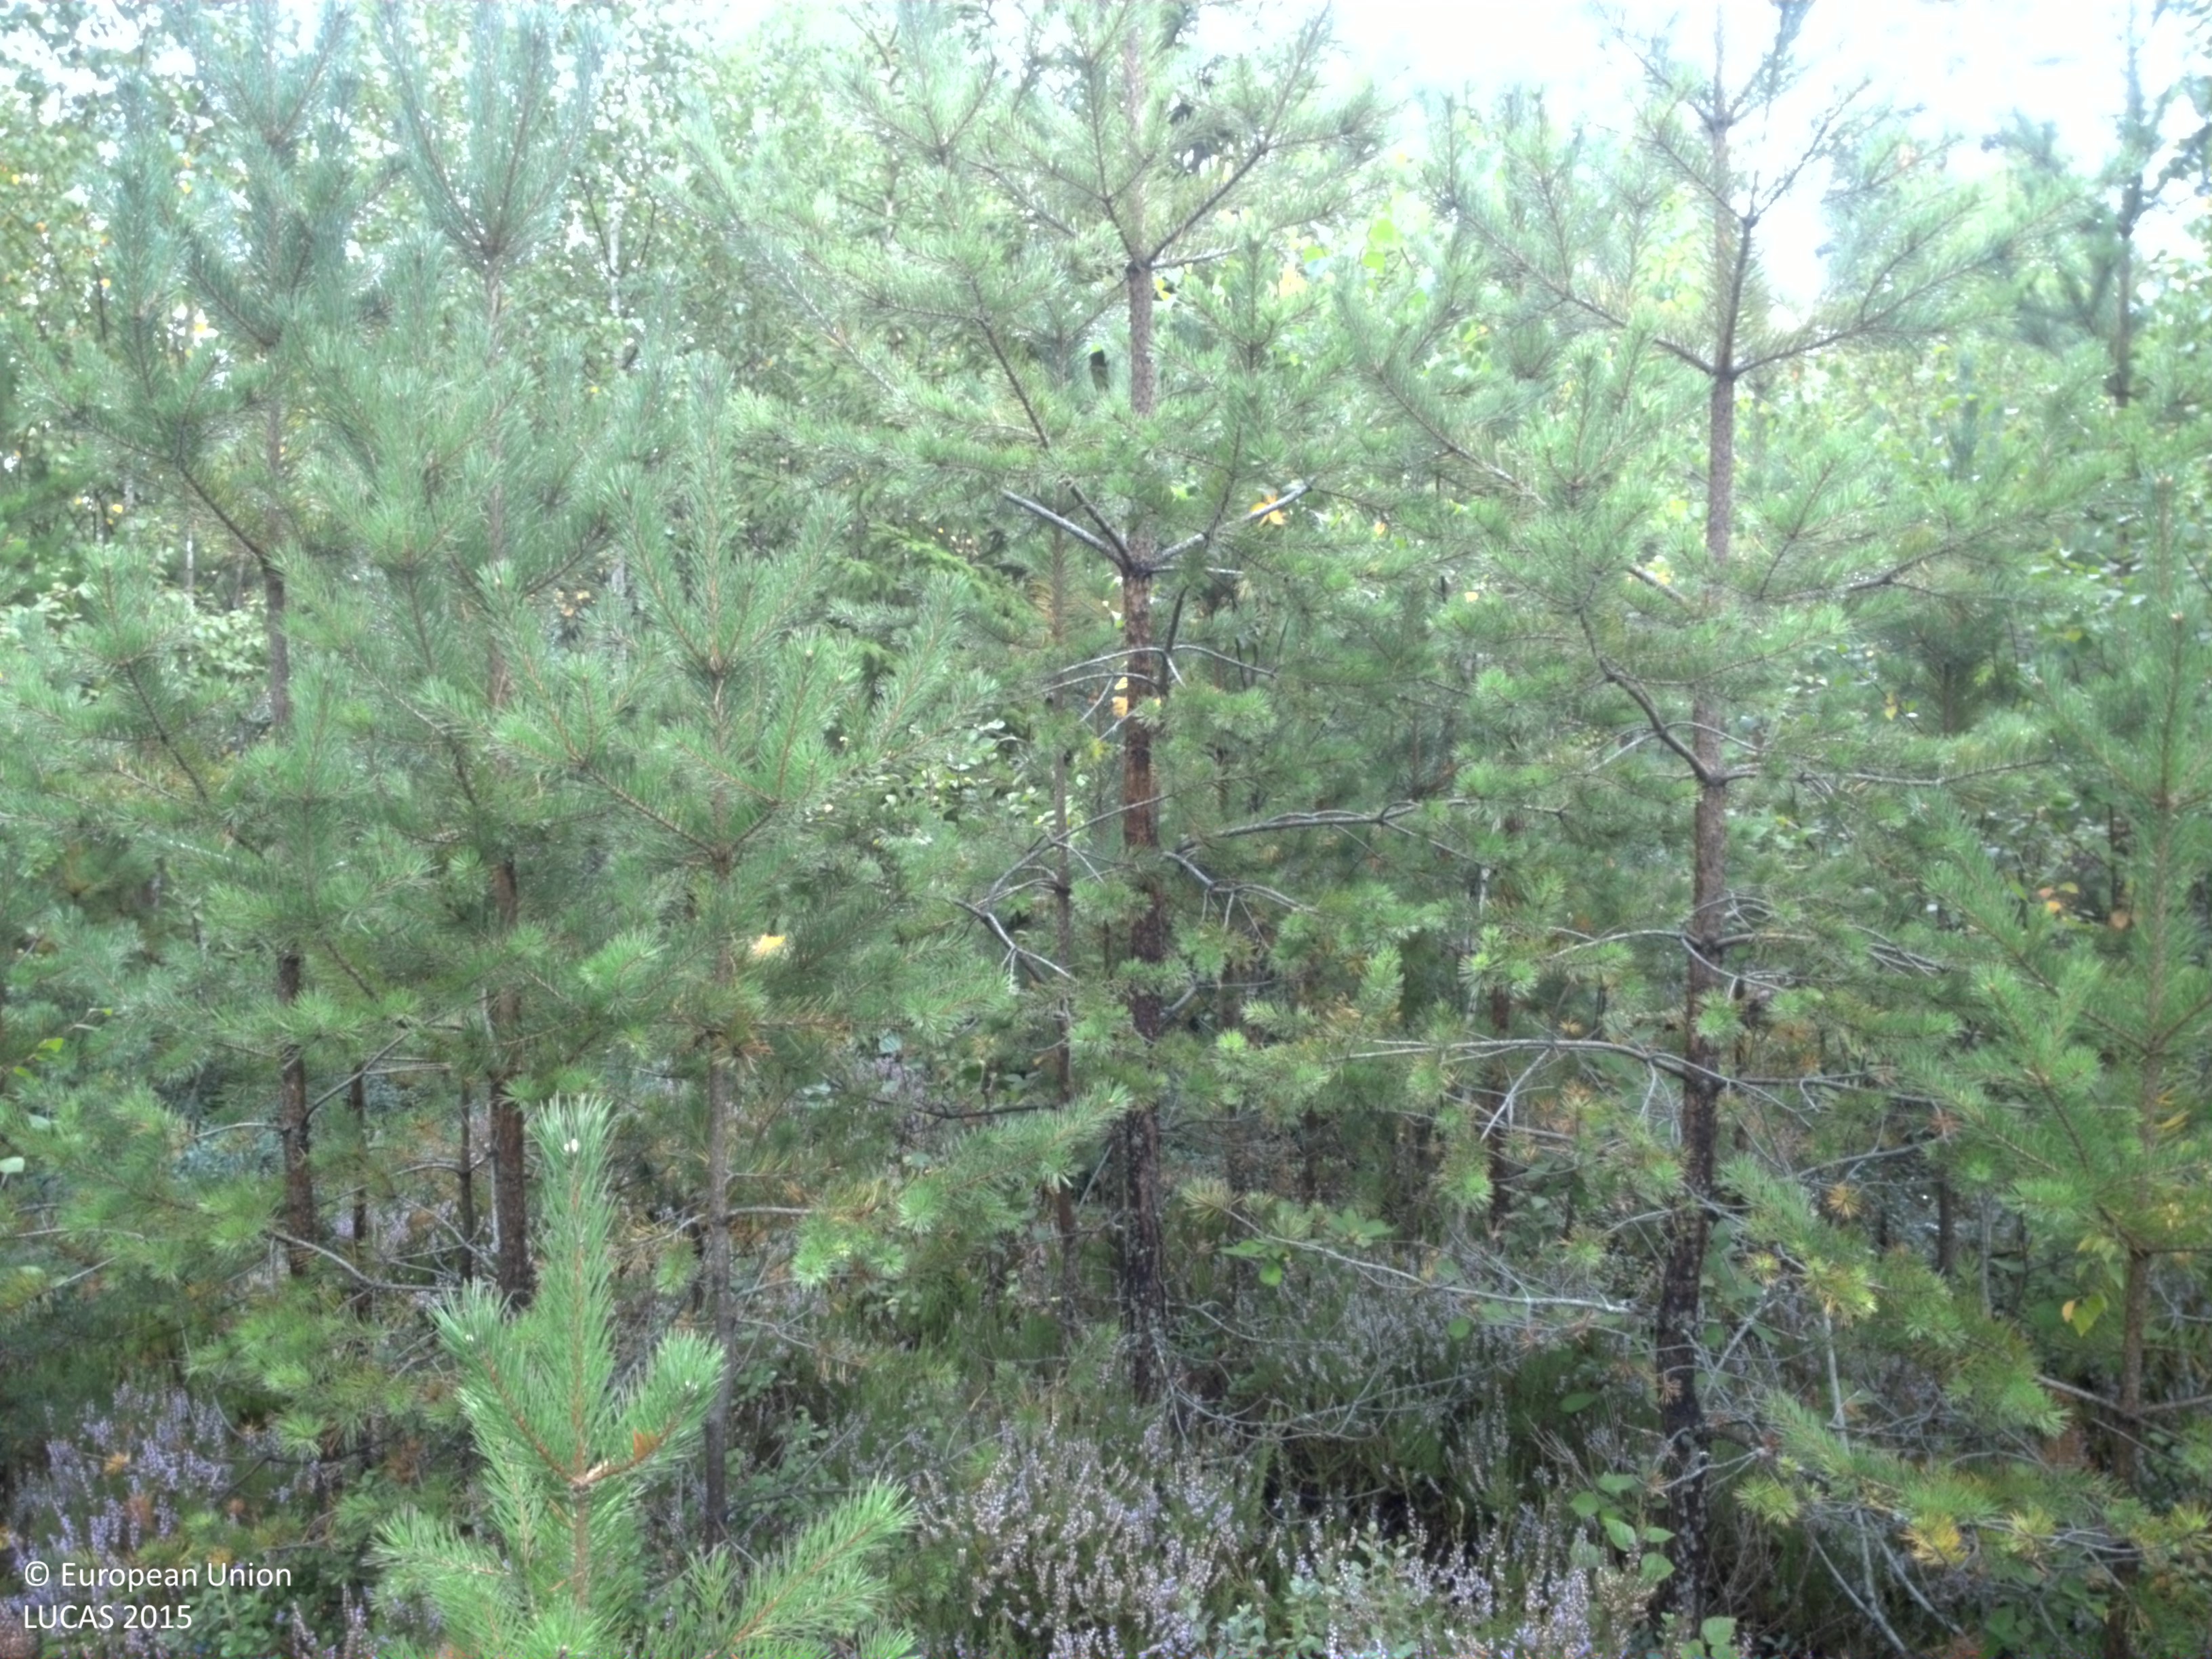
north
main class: Woodland
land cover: Pine dominated mixed woodland
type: boreal forest
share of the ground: 50 - 75 %
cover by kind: shrubs 35 %, coniferous forest trees 30 %, broadleaved forest trees 25 %, lichens and mosses 10 %
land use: Forestry
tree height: > 5 m
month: August
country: SE
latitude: 59.7972
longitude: 15.6395
